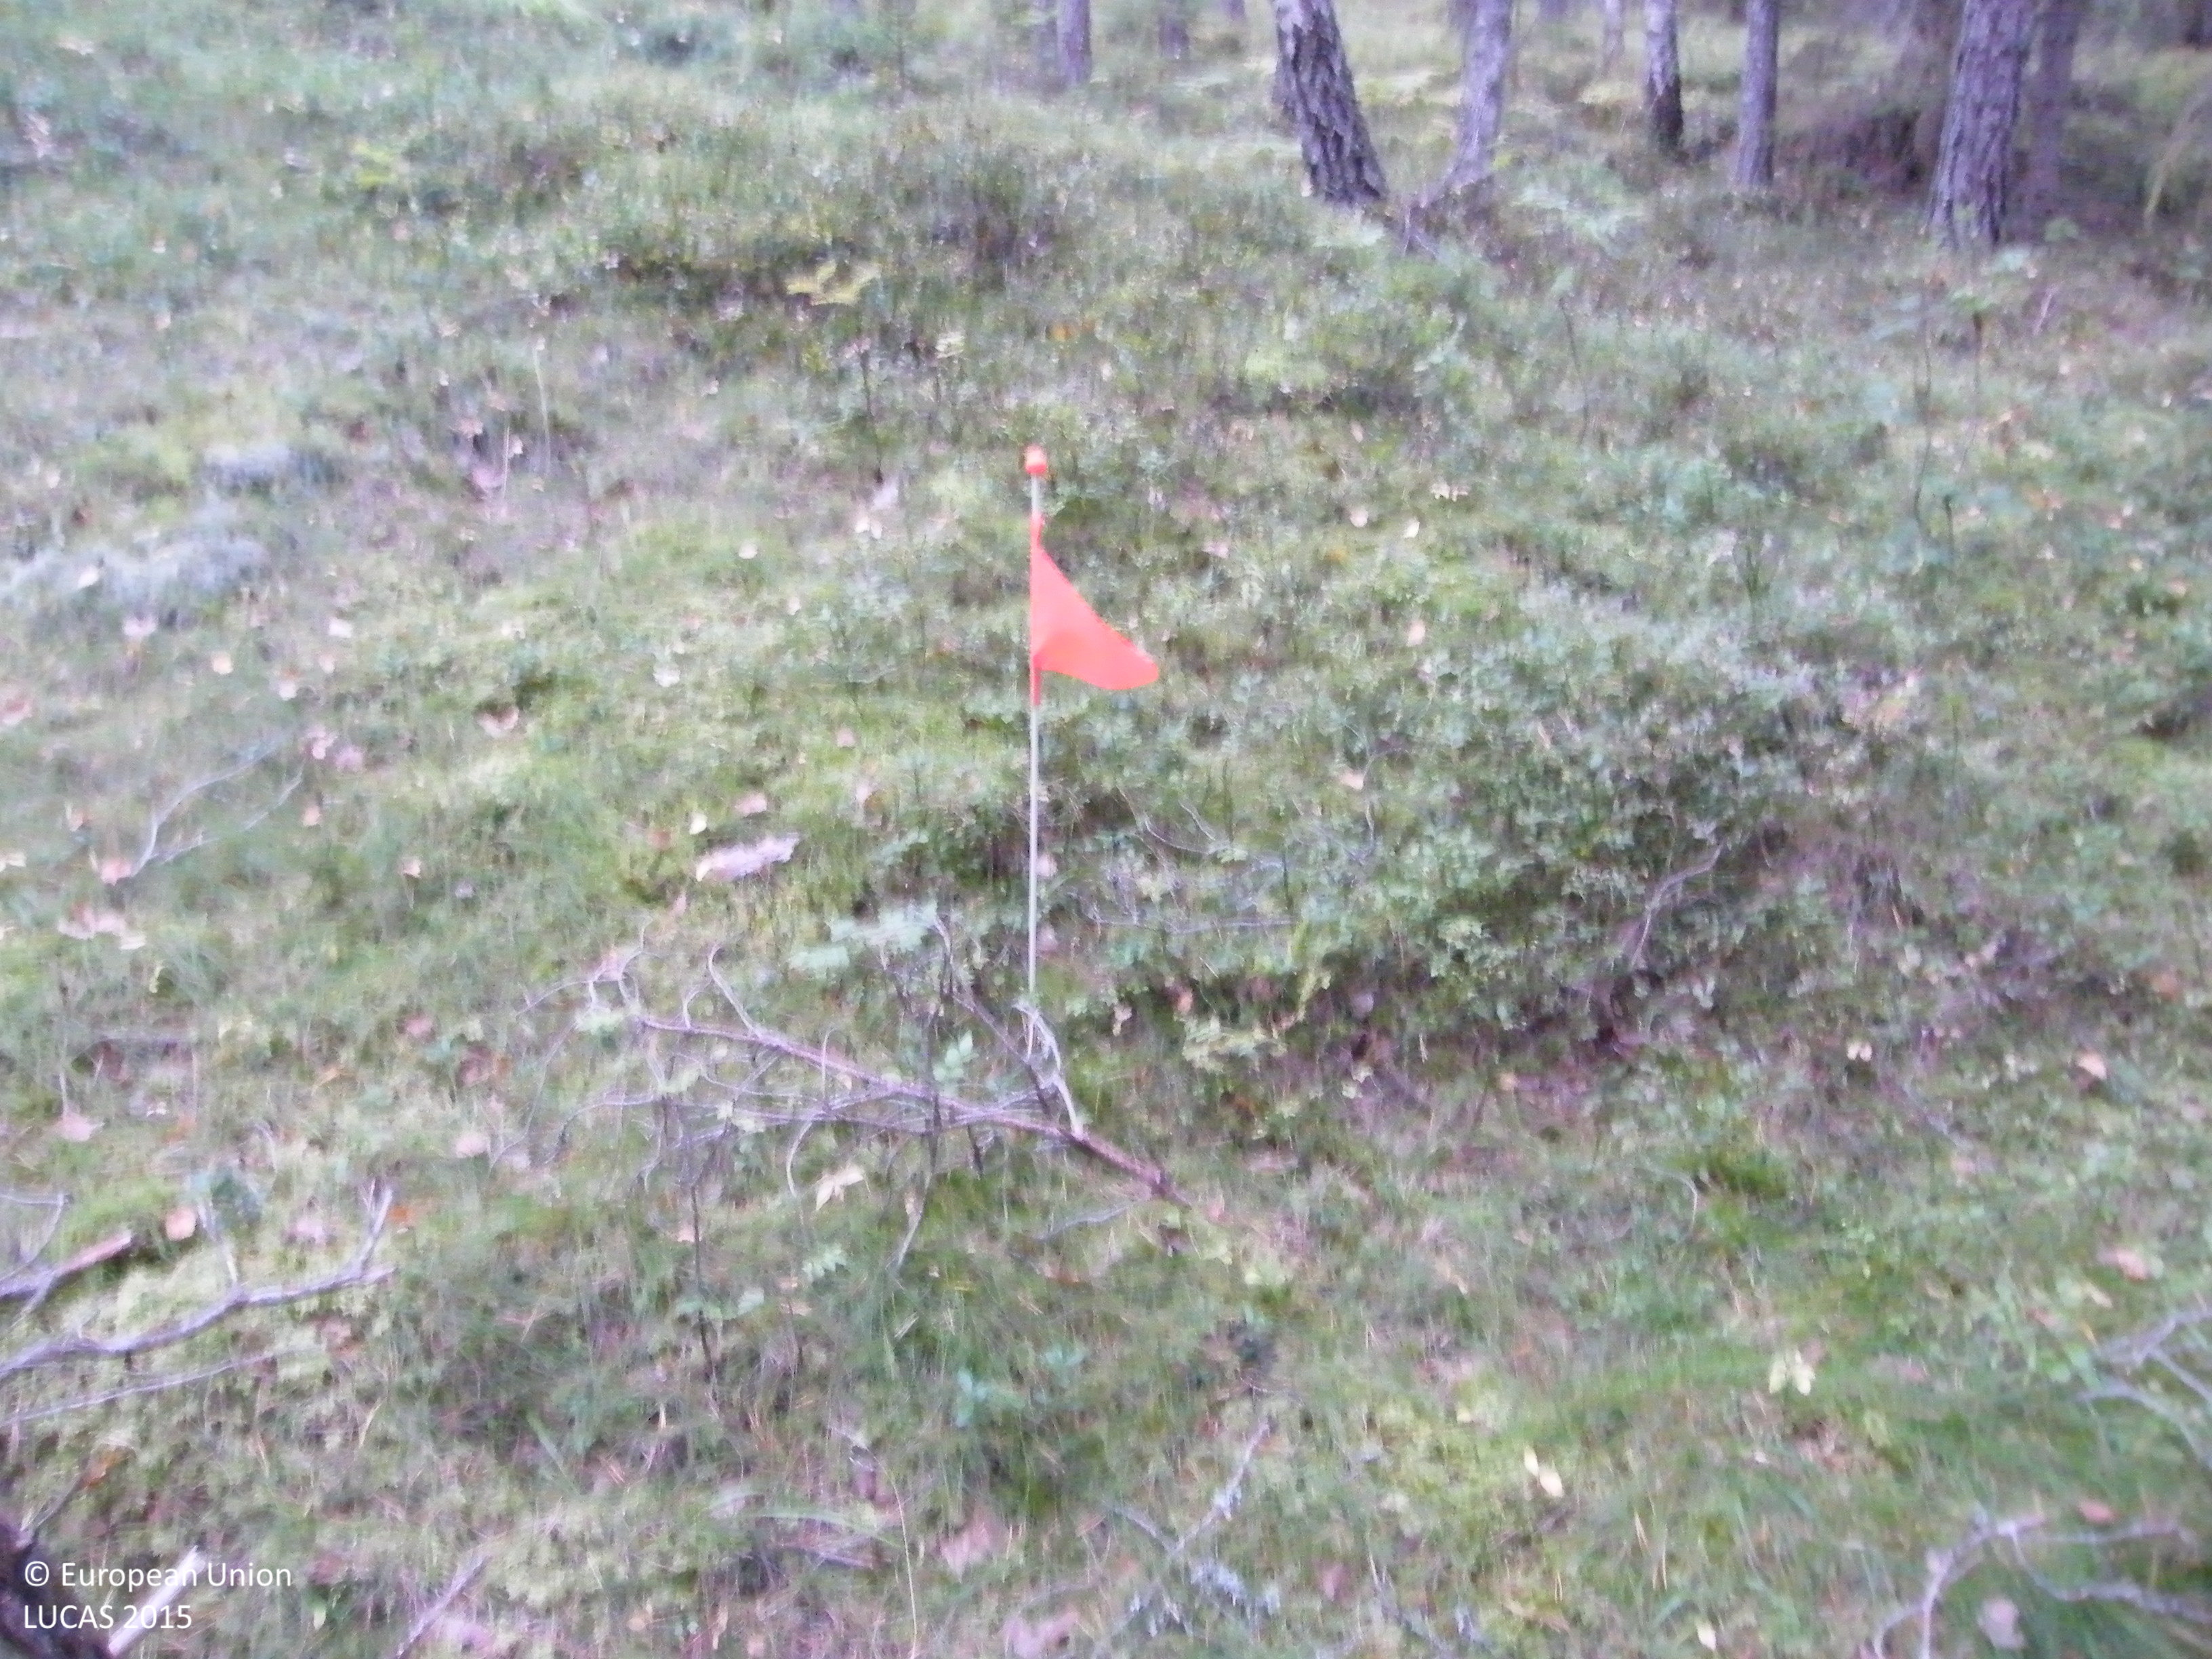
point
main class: Woodland
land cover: Other mixed woodland
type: boreal forest
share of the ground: 50 - 75 %
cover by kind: coniferous forest trees 45 %, broadleaved forest trees 20 %, shrubs 20 %, lichens and mosses 15 %
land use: Forestry
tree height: > 5 m
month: September
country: SE
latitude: 59.7311
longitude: 15.4862
